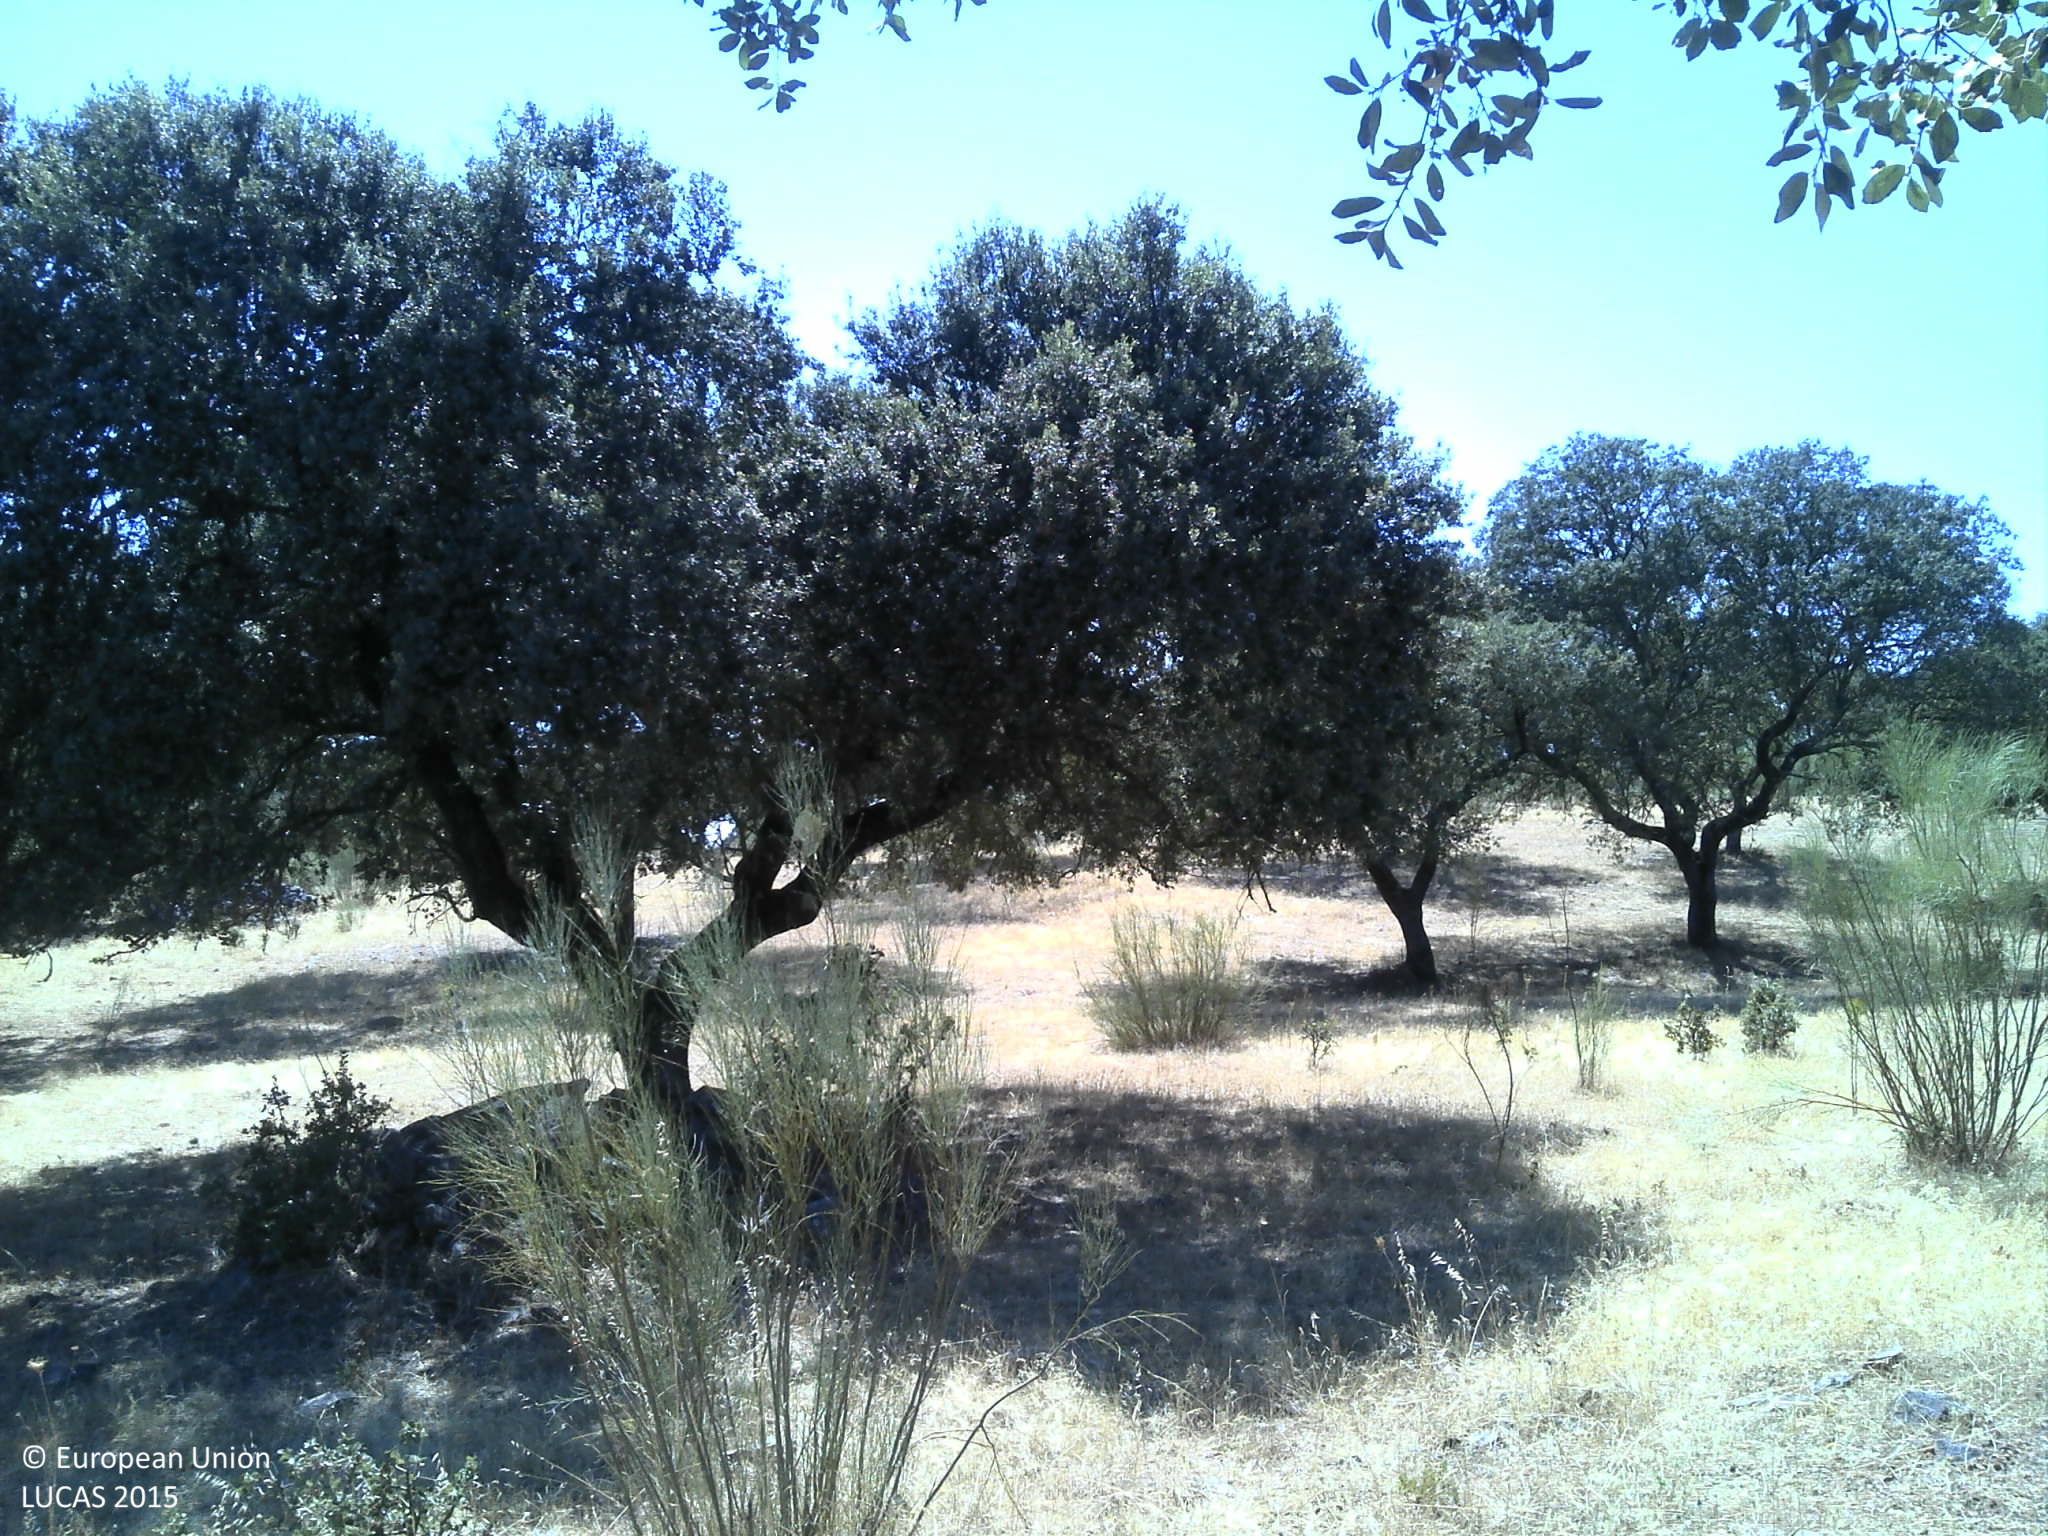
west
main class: Woodland
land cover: Broadleaved woodland
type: broadleaved evergreen forest
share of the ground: 25 - 50 %
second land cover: Grassland without tree/shrub cover
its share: 10 - 25 %
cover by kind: unconsolidated bare surface 60 %, broadleaved forest trees 25 %, herbaceous plants 10 %, shrubs 5 %
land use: Forestry
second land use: Agriculture (excluding fallow land and kitchen gardens)
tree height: > 5 m
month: July
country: PT
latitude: 39.0813
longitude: -7.5301
